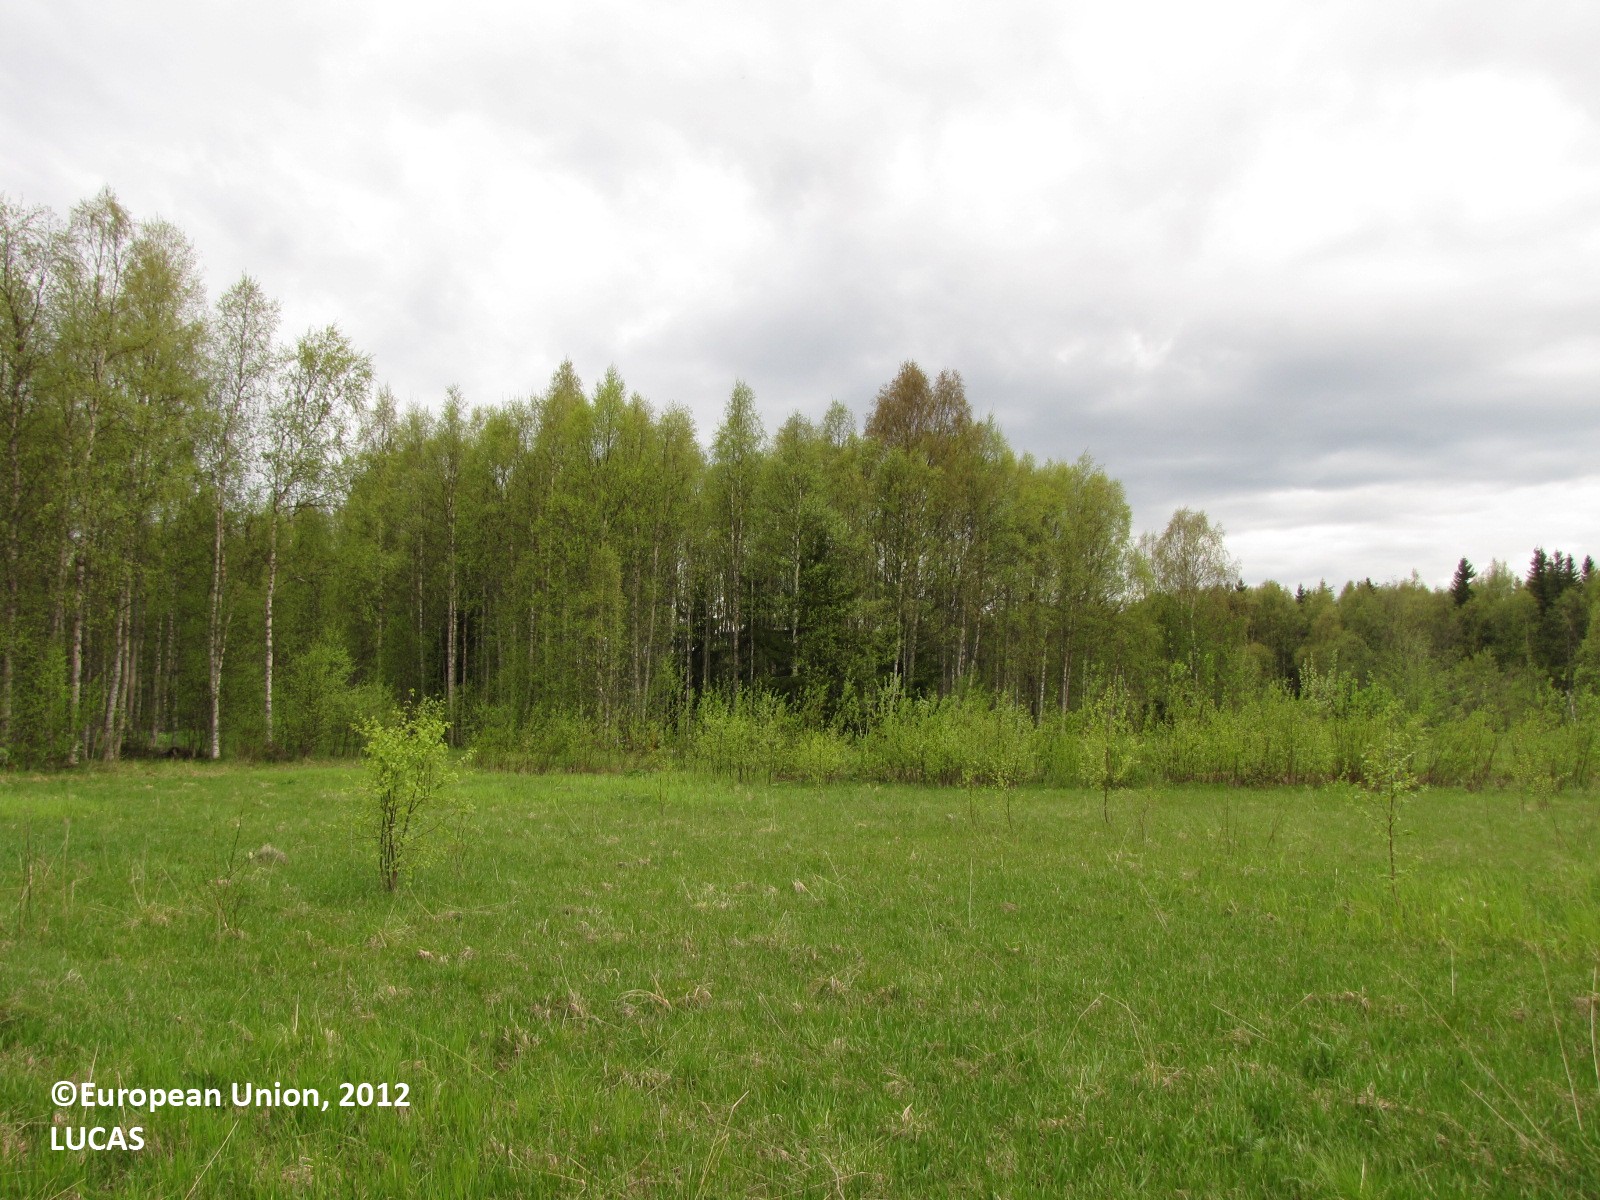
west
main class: Grassland
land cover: Grassland with sparse tree/shrub cover
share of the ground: > 75 %
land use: Agriculture (excluding fallow land and kitchen gardens)
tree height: < 5 m
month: June
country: FI
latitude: 65.7971
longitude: 24.4586
